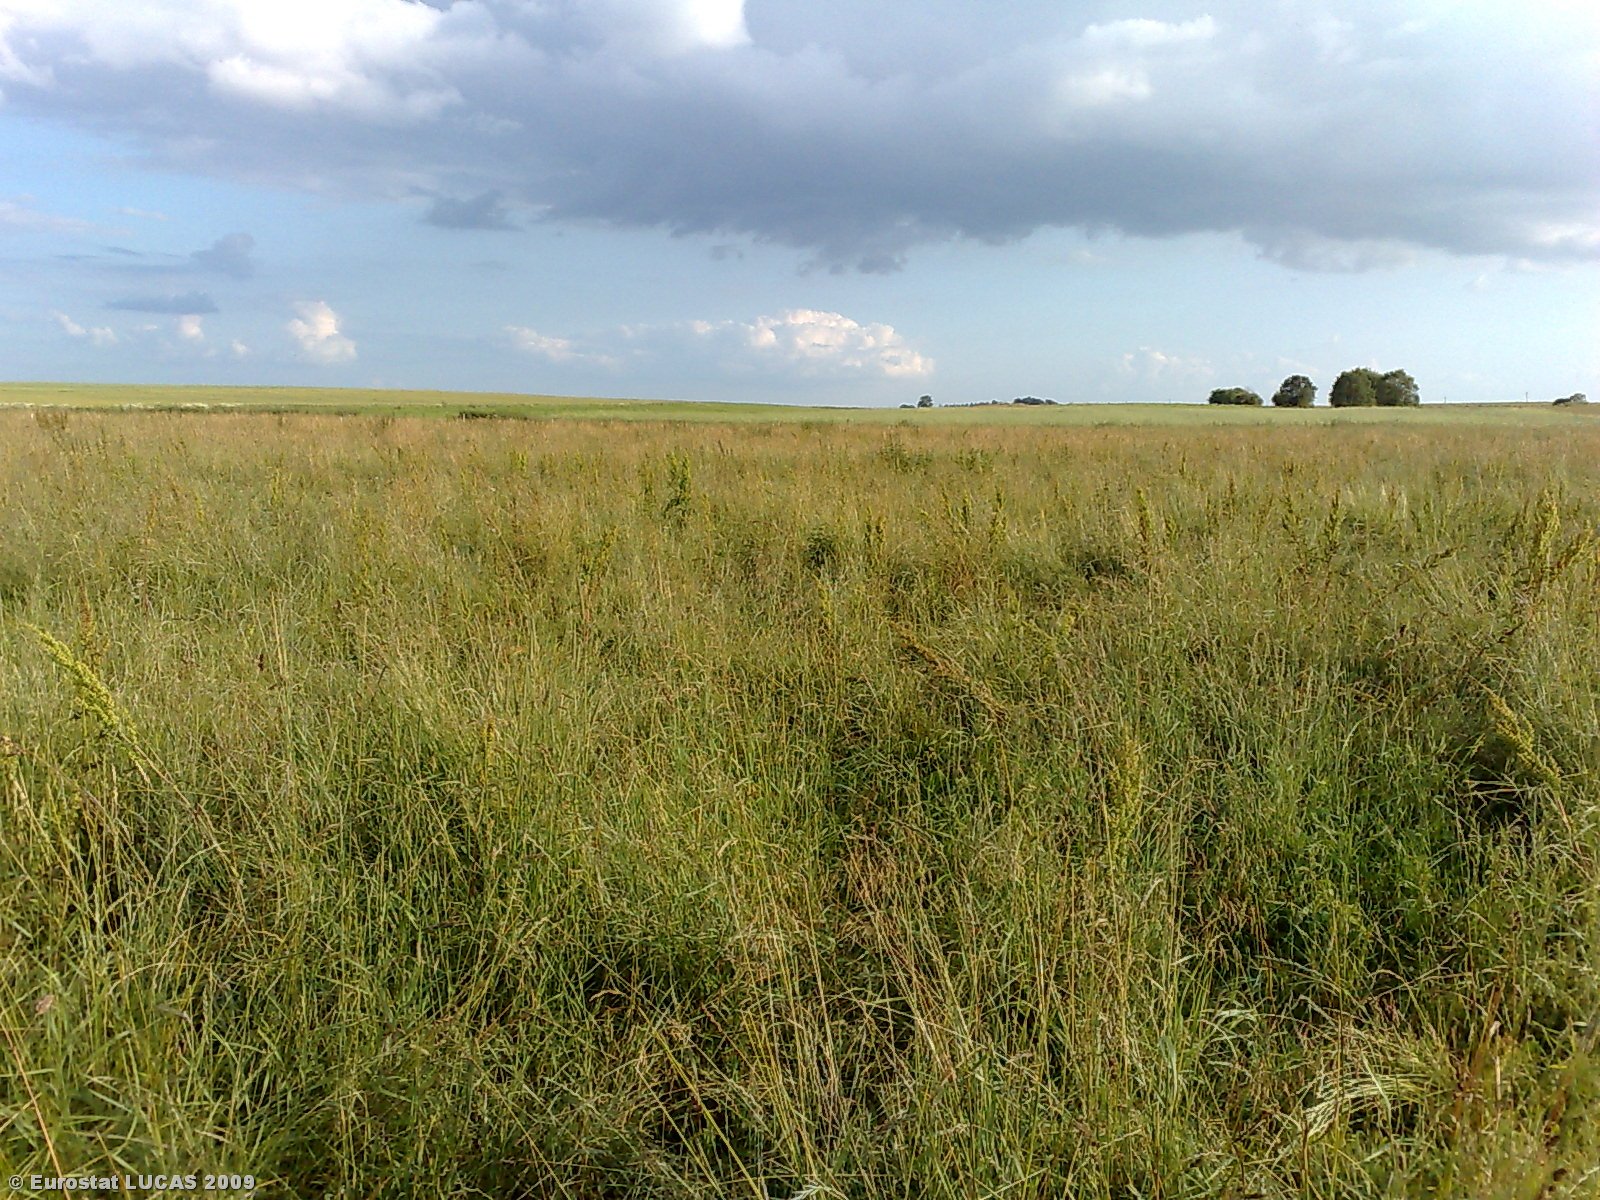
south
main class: Grassland
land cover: Grassland without tree/shrub cover
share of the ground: > 75 %
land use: Agriculture (excluding fallow land and kitchen gardens)
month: July
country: LT
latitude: 55.7767
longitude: 22.8360
